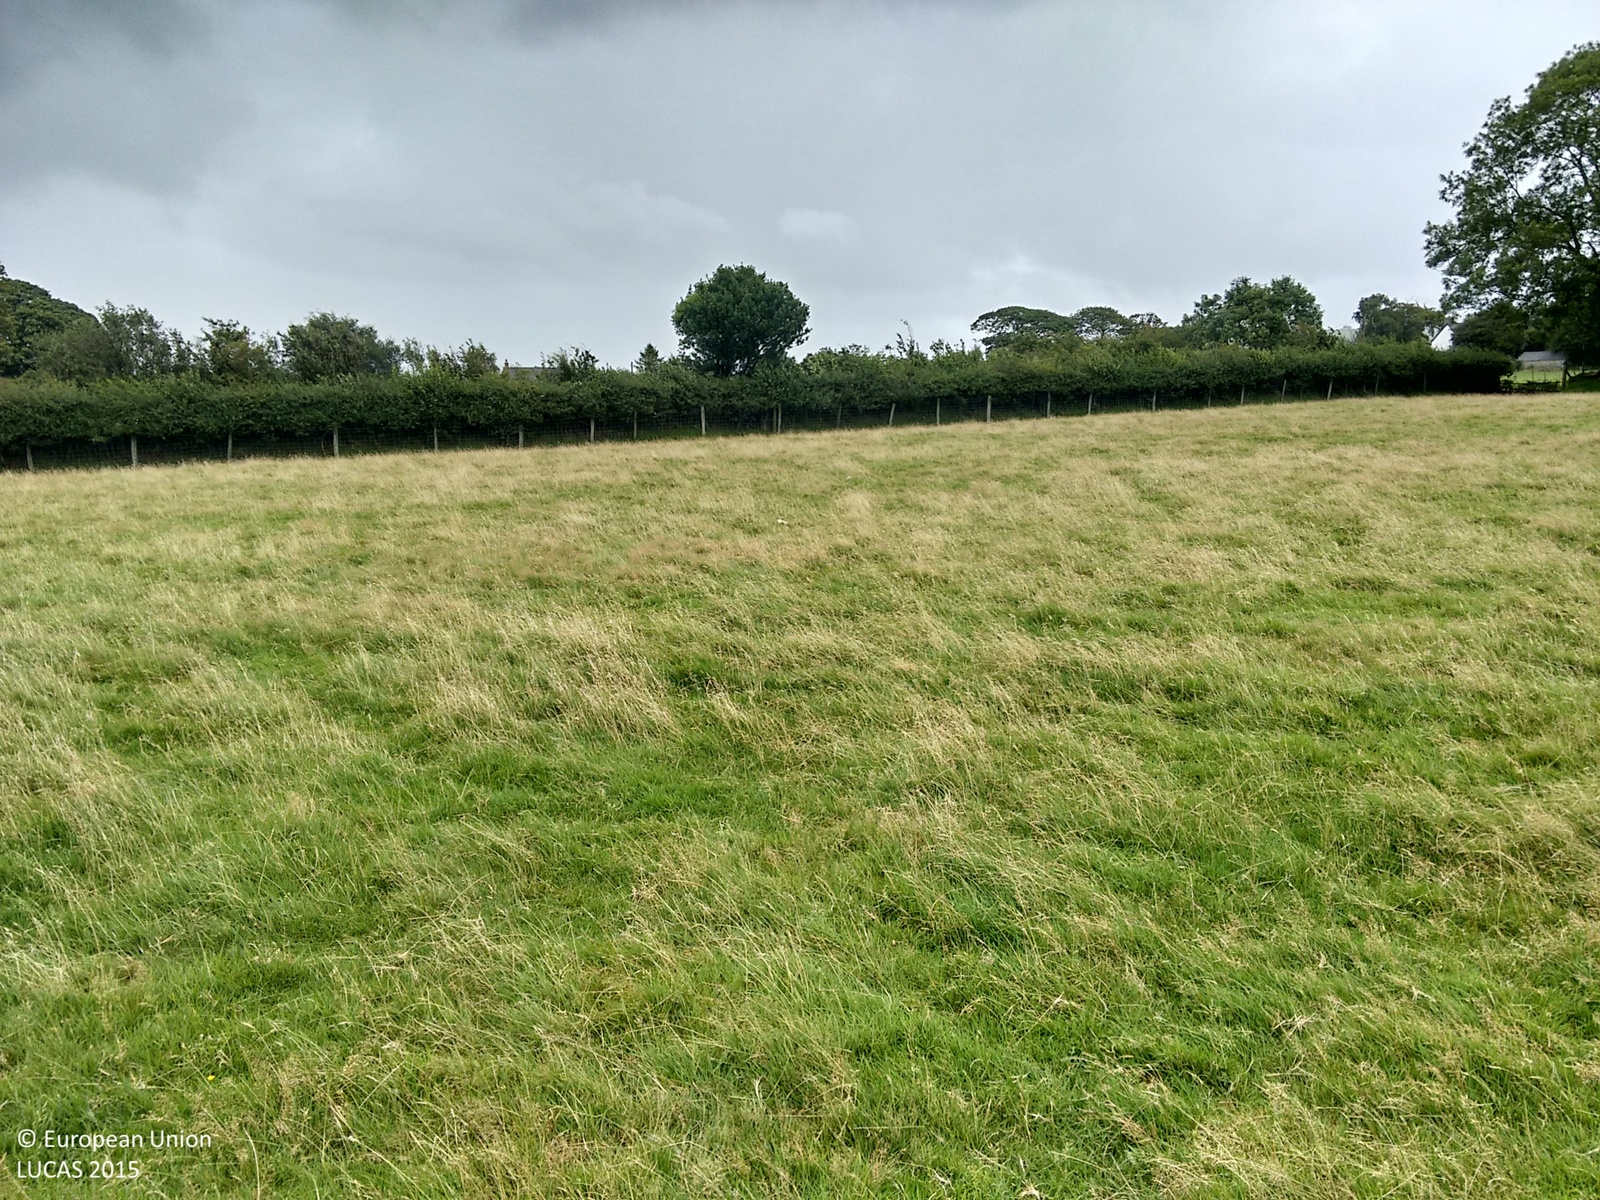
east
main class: Grassland
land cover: Grassland without tree/shrub cover
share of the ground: > 75 %
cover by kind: herbaceous plants 100 %
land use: Agriculture (excluding fallow land and kitchen gardens)
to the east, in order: Grassland without tree/shrub cover; Fences; Managed hedges; Single bushes/trees; Grassland without tree/shrub cover; Fences; Grassland without tree/shrub cover; Fences; Managed hedges; Fences; Grassland without tree/shrub cover; Fences; Electric lines; Managed hedges; Paved roads, cycling and walking lanes; Managed hedges; Electric lines; Single bushes/trees; Fences; Temporary grasslands
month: August
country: GB
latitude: 51.9983
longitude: -4.6002
